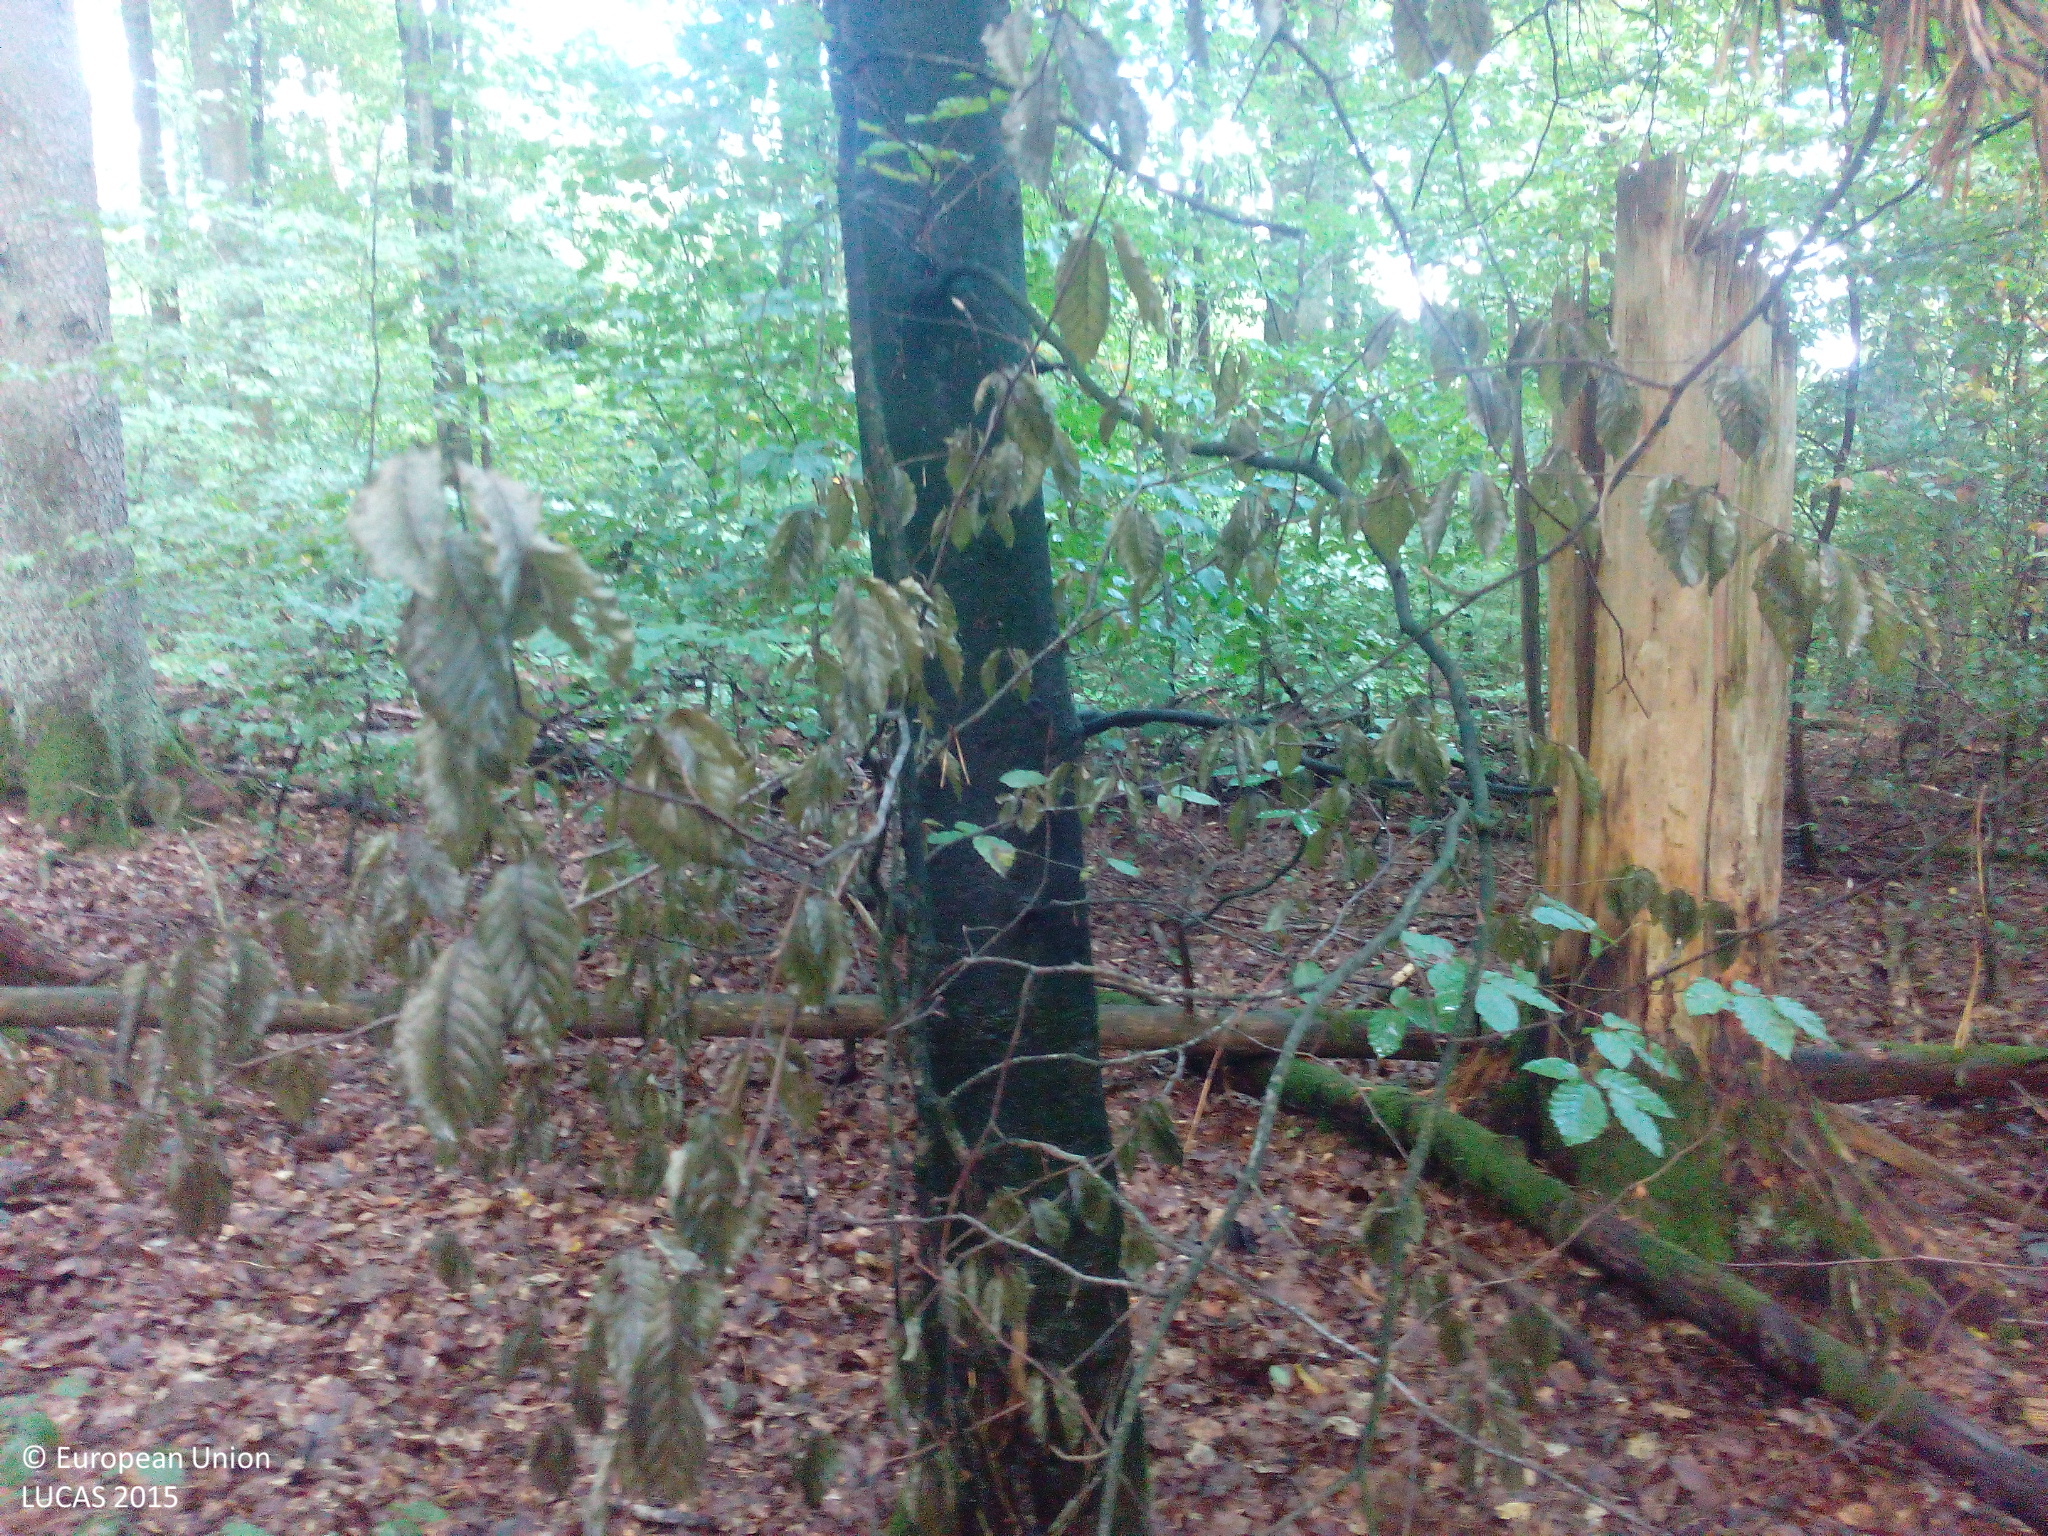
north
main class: Woodland
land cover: Broadleaved woodland
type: beech forest
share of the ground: > 75 %
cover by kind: broadleaved forest trees 85 %, coniferous forest trees 10 %, unconsolidated bare surface 5 %
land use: Forestry
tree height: > 5 m
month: September
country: DE
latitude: 49.8965
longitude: 9.9304
